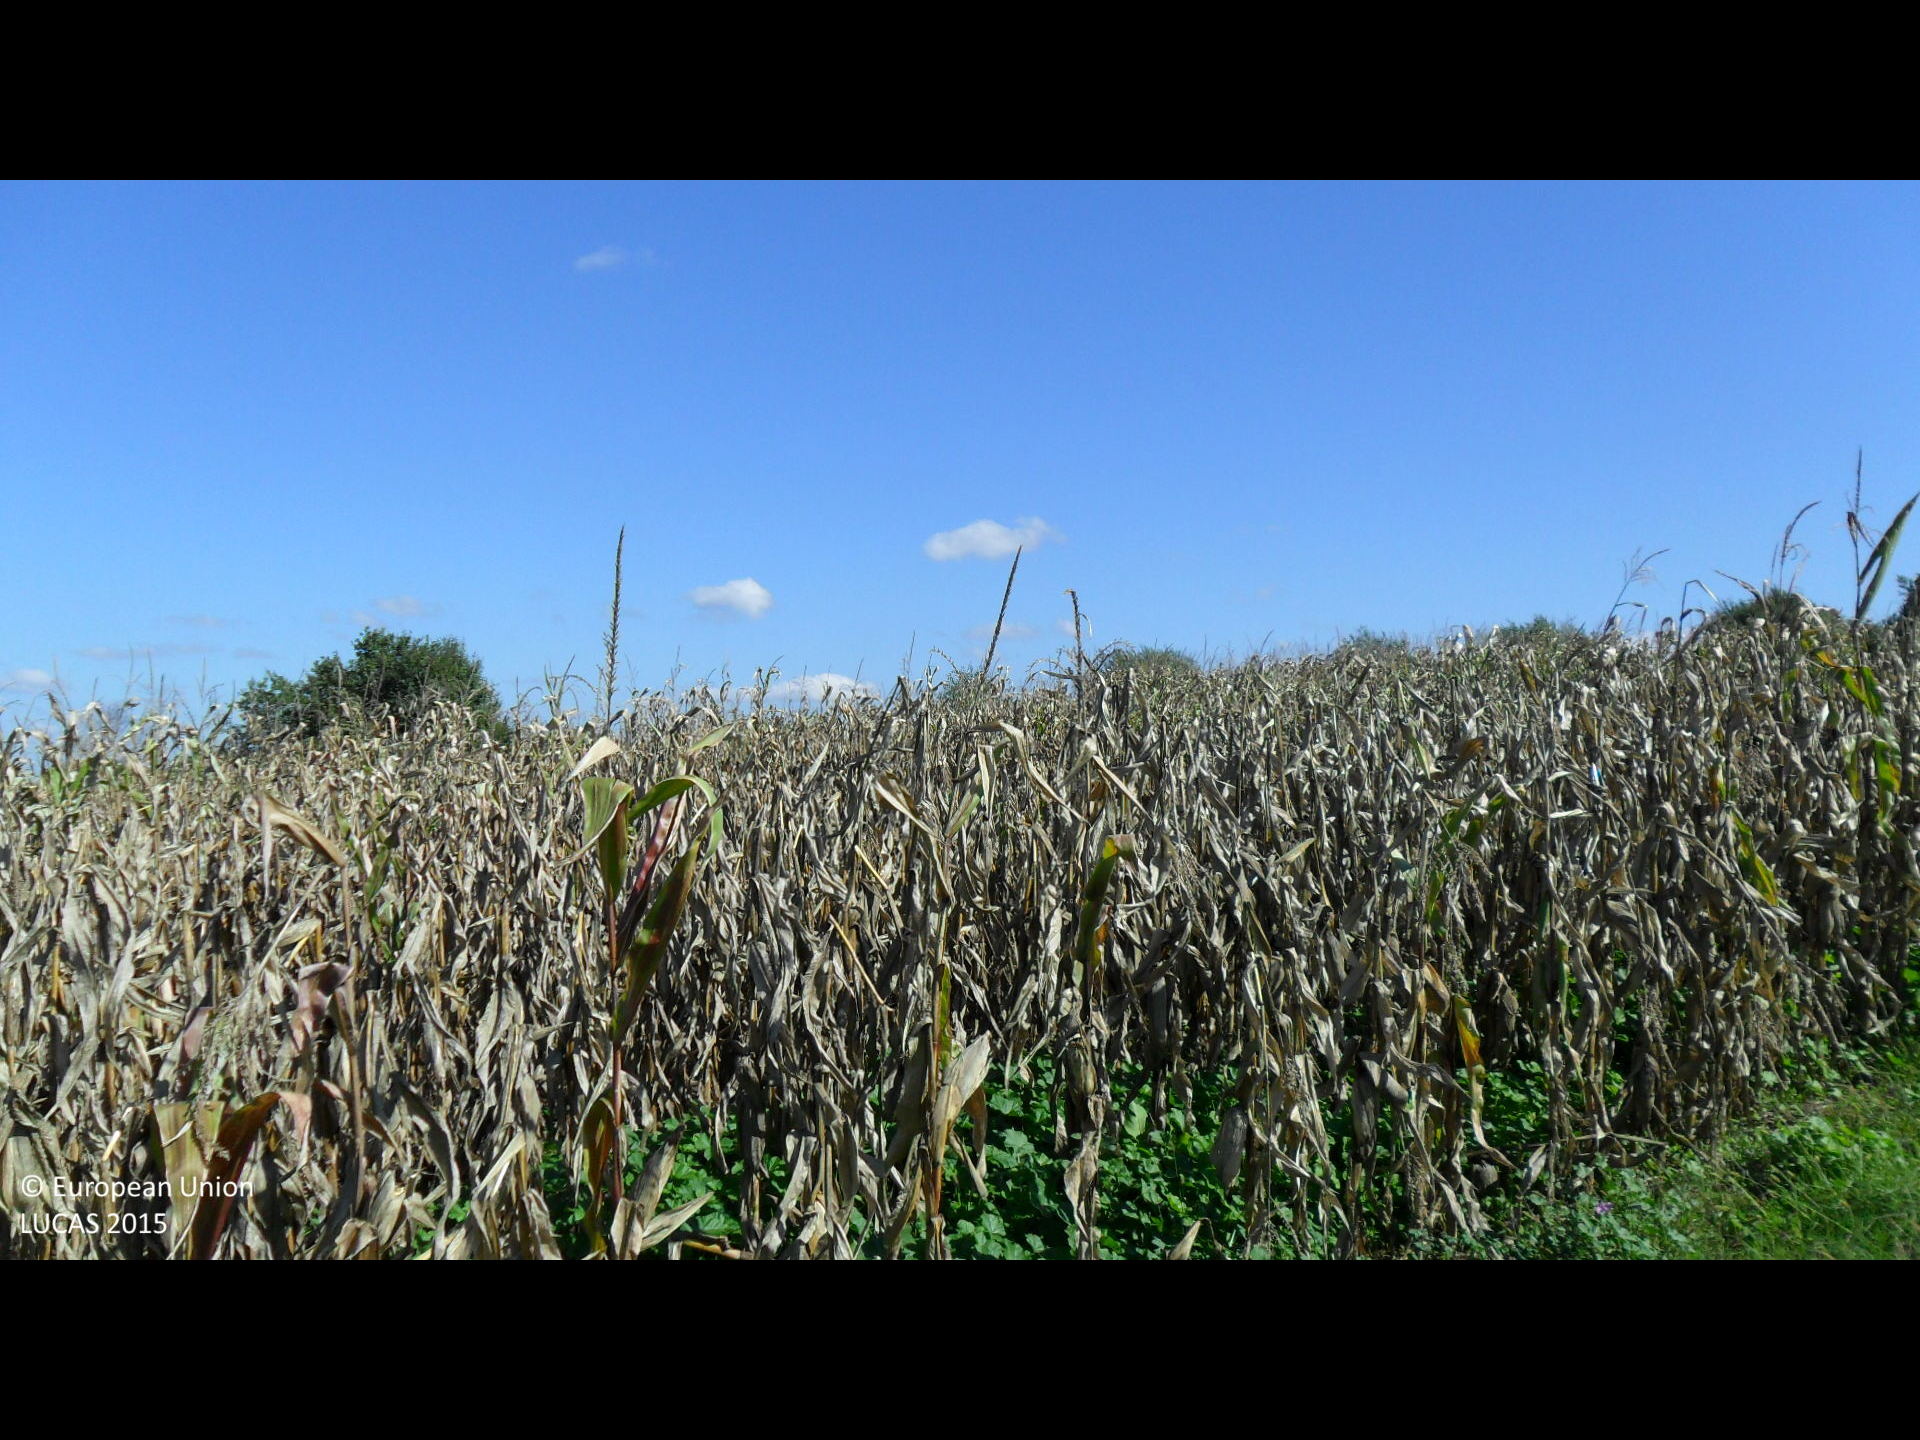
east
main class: Cropland
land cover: Maize
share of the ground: > 75 %
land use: Agriculture (excluding fallow land and kitchen gardens)
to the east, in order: Tracks; Grass margins; Maize; Shrubland with sparse tree cover; Sunflower
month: October
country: BG
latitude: 43.1407
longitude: 26.0861
